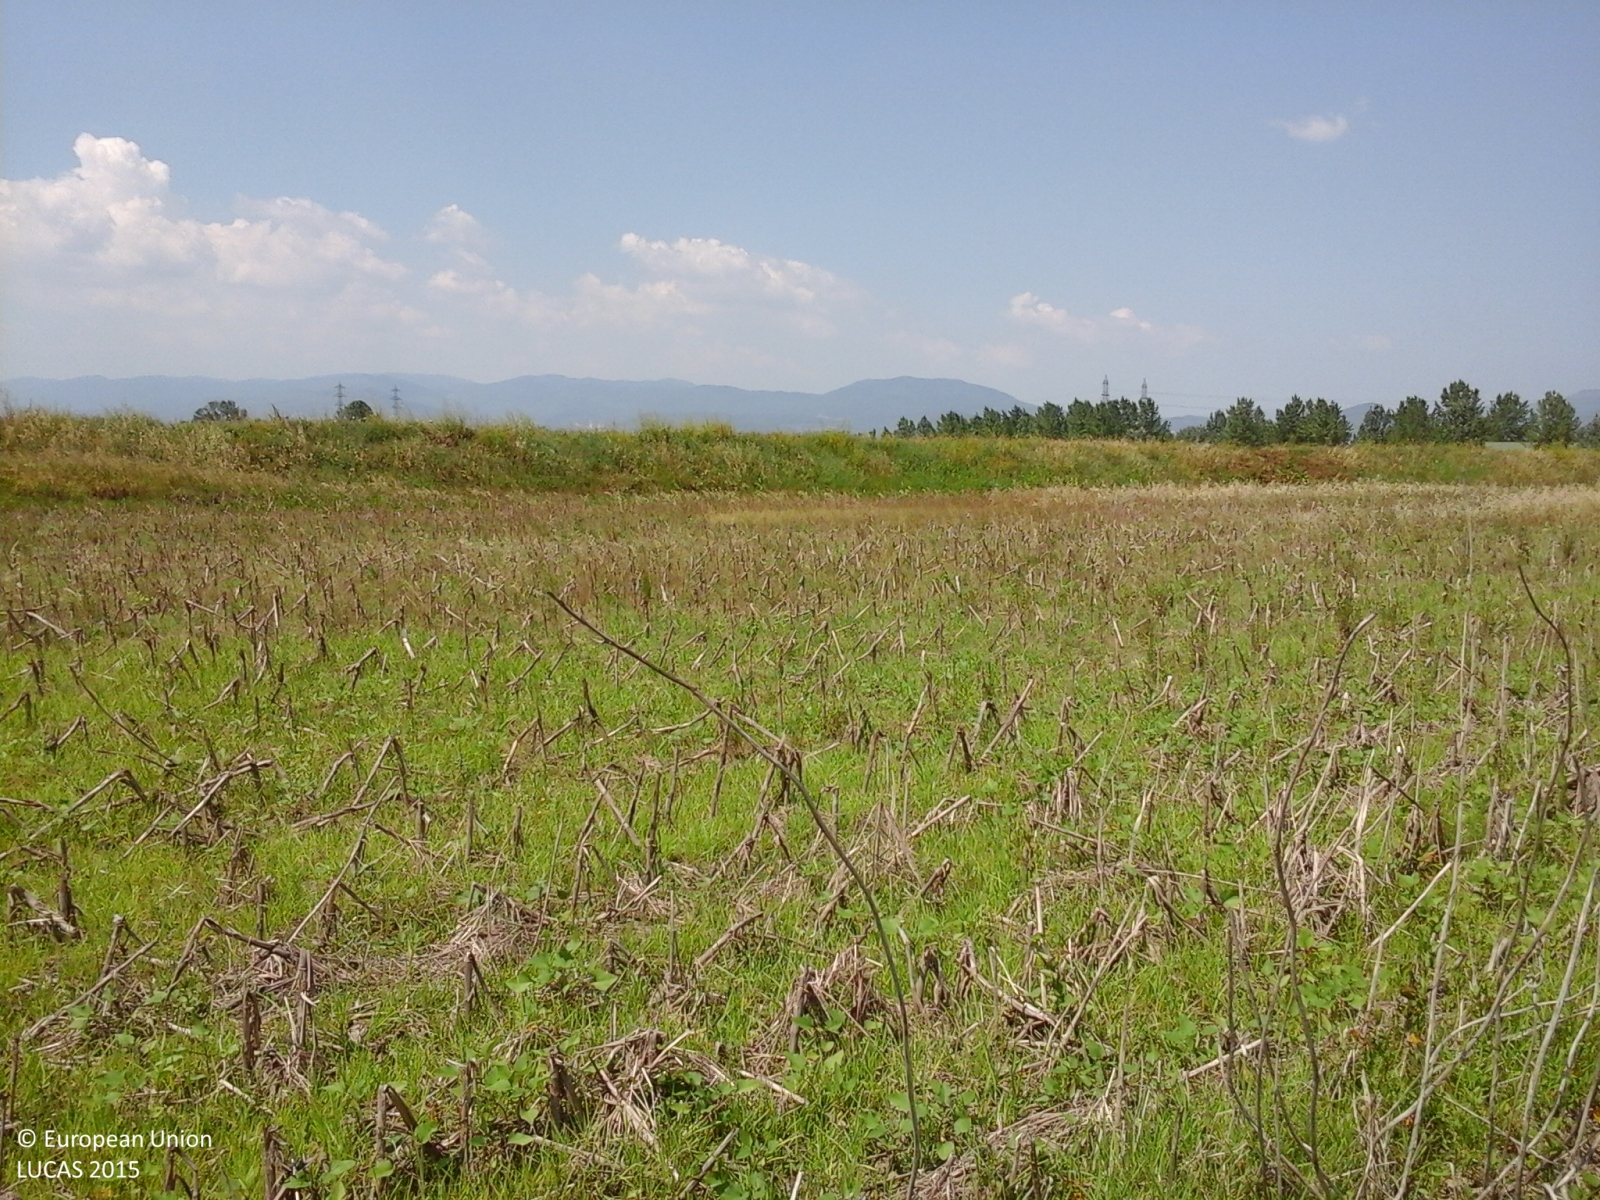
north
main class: Grassland
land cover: Spontaneously vegetated surfaces
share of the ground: > 75 %
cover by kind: herbaceous plants 100 %
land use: Agriculture (excluding fallow land and kitchen gardens)
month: June
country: IT
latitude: 43.8220
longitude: 11.0541
